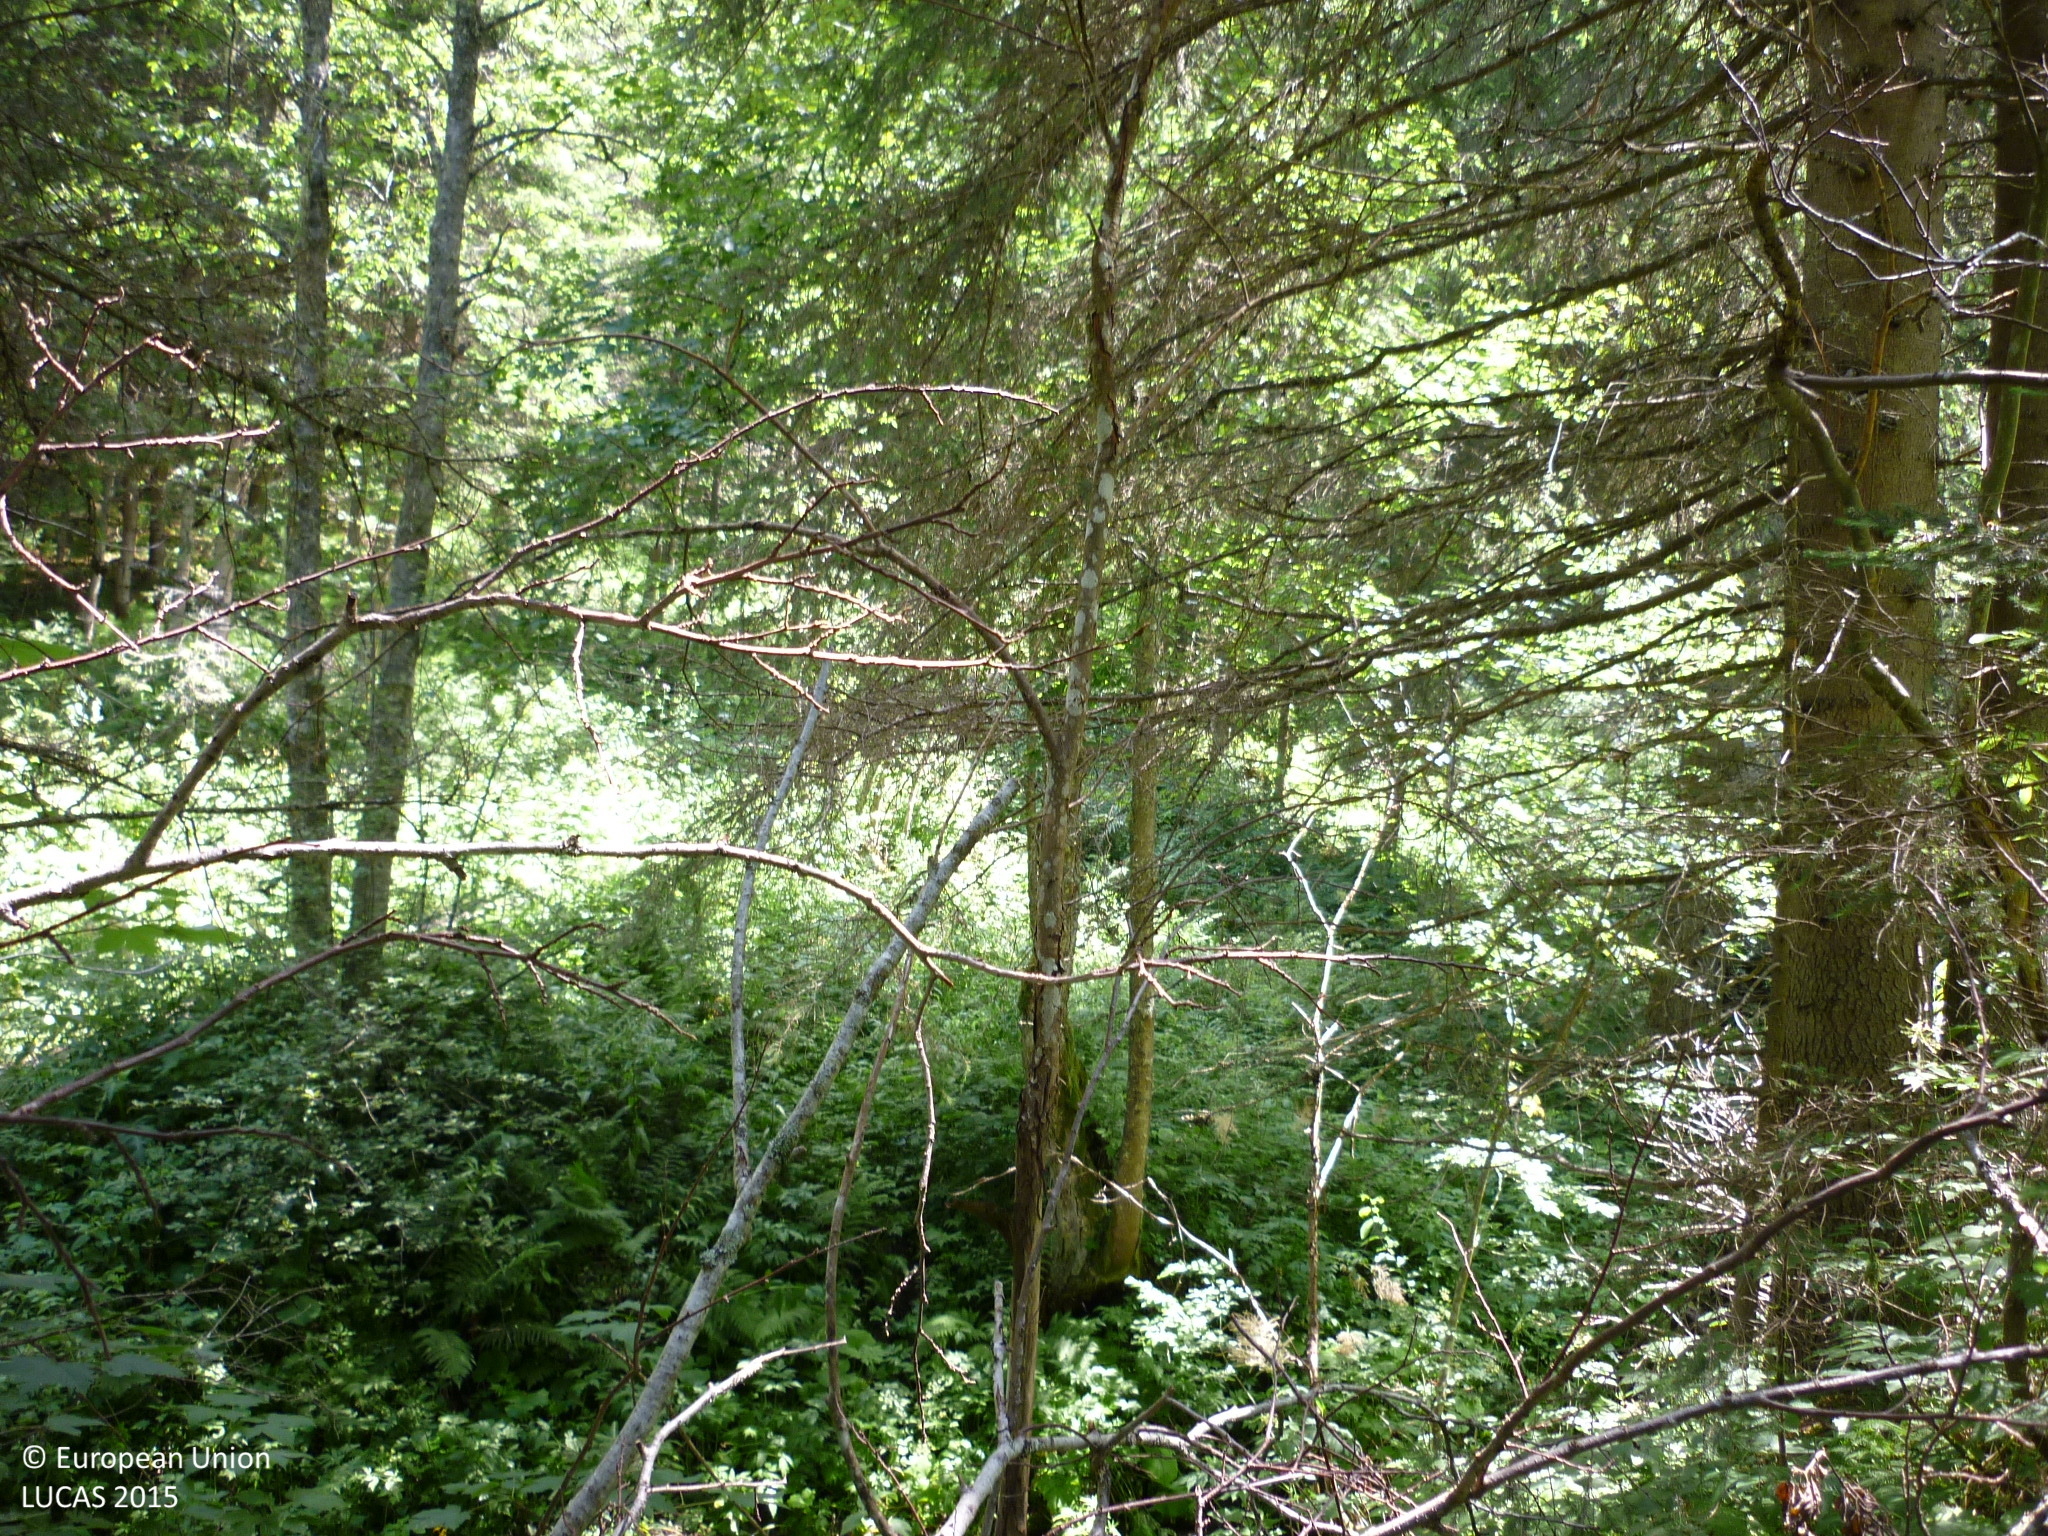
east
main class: Woodland
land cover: Spruce dominated coniferous woodland
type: alpine coniferous forest
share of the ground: > 75 %
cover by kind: coniferous forest trees 80 %, broadleaved forest trees 5 %, shrubs 5 %, herbaceous plants 5 %, lichens and mosses 5 %
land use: Forestry
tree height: > 5 m
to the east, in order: Spruce dominated coniferous woodland; Rivers and streams; Spruce dominated mixed woodland; Spruce dominated coniferous woodland; Rivers and streams; Spruce dominated coniferous woodland; Rivers and streams; Spruce dominated coniferous woodland; Fences; Grassland without tree/shrub cover; Spruce dominated coniferous woodland
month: July
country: AT
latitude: 47.0401
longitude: 14.3018
